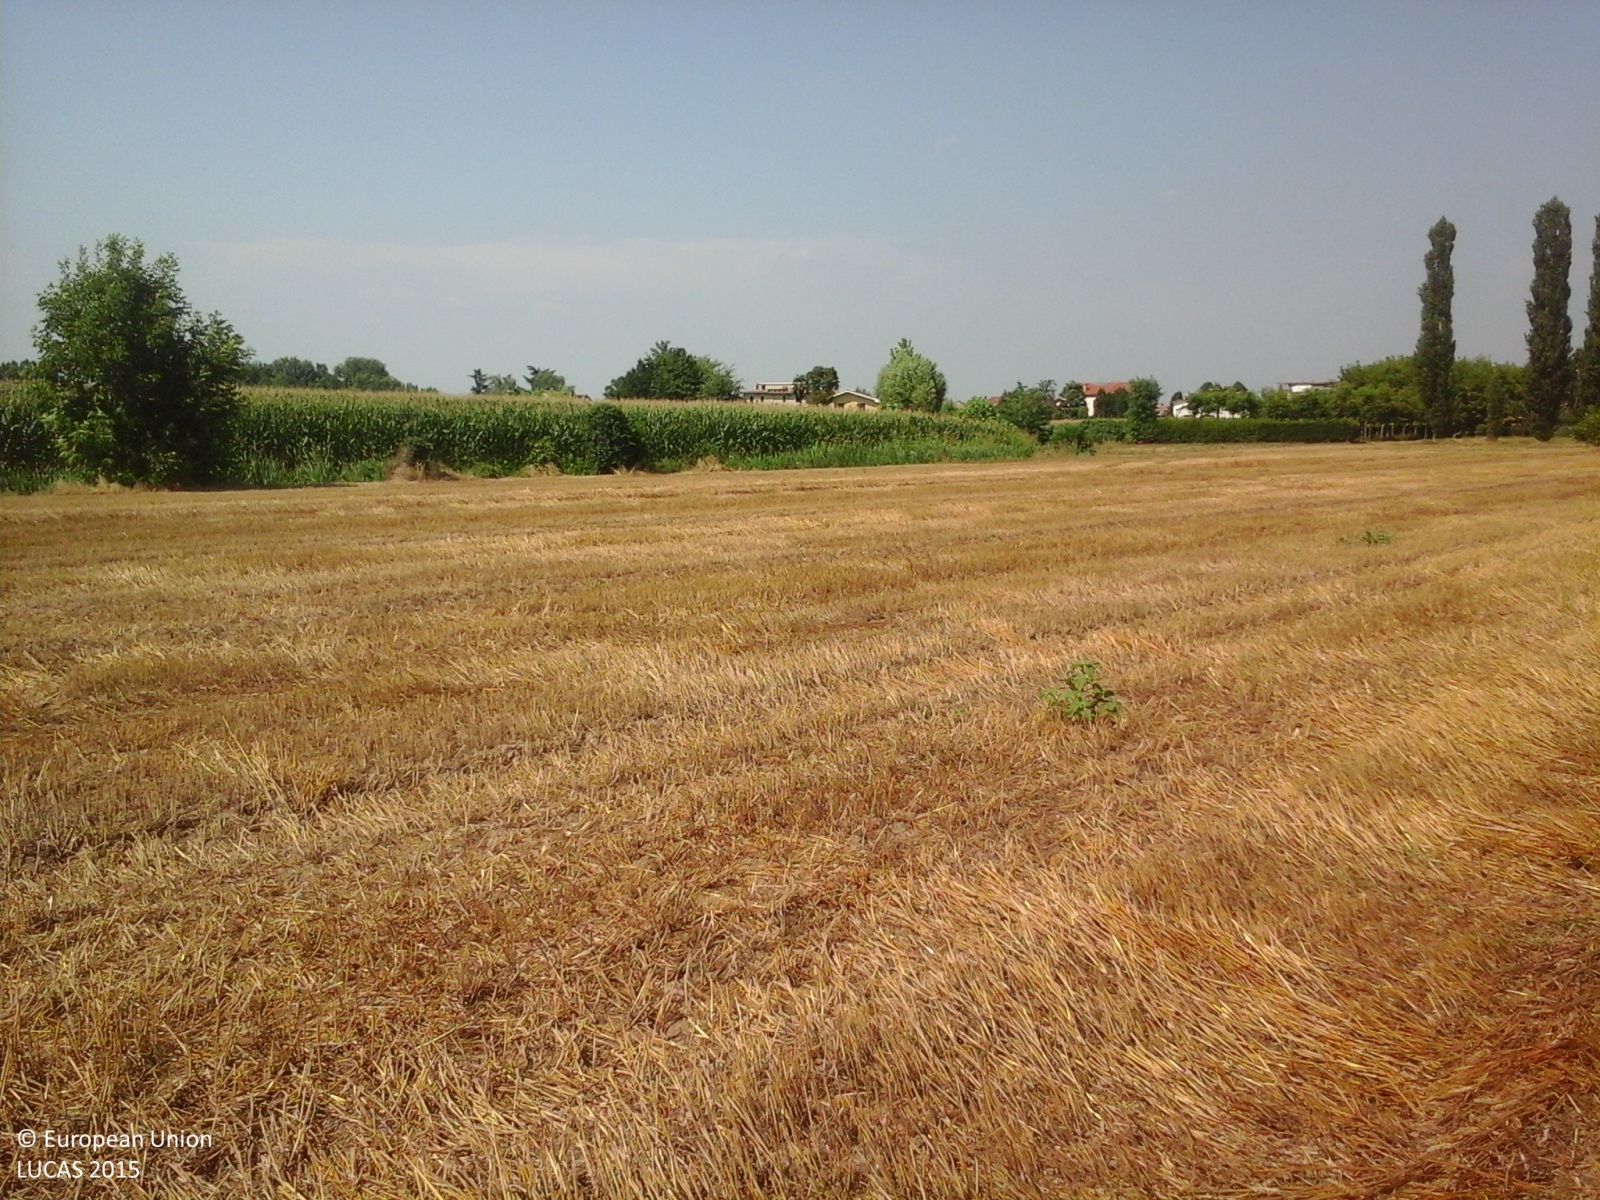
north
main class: Cropland
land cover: Common wheat
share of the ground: > 75 %
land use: Agriculture (excluding fallow land and kitchen gardens)
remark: Harvested field
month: July
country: IT
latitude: 45.2165
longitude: 11.9195
